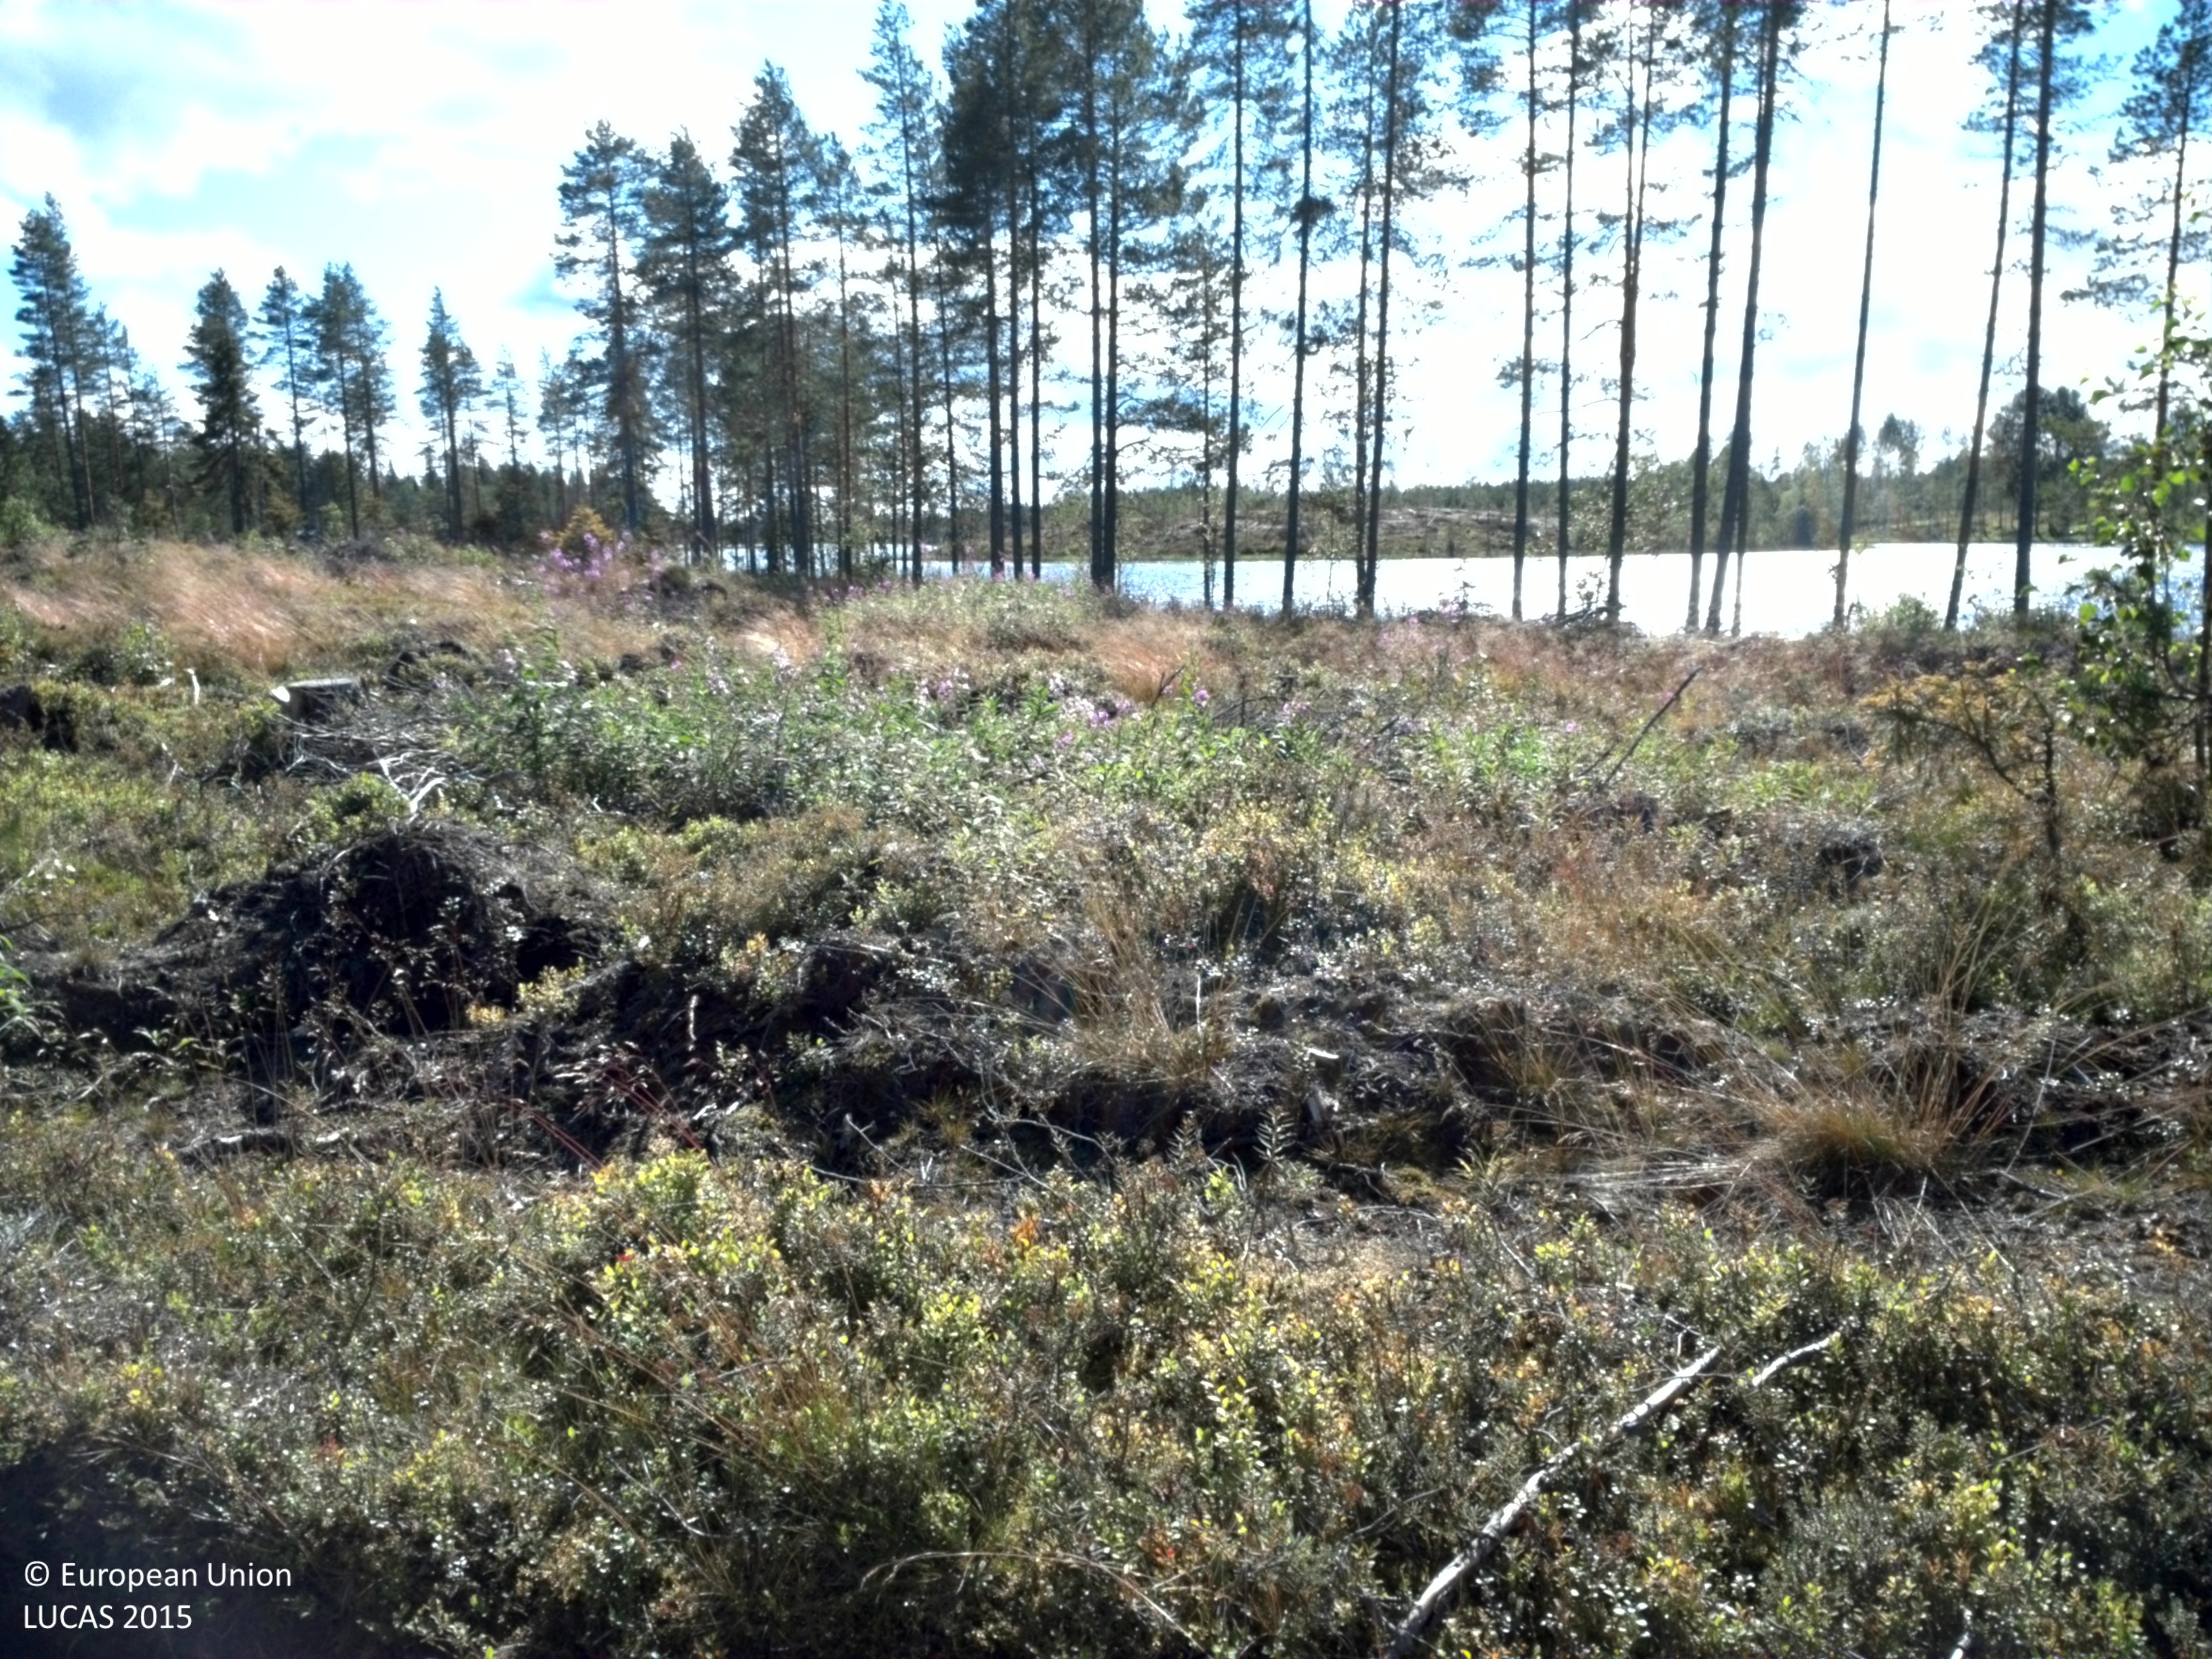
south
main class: Shrubland
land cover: Shrubland with sparse tree cover
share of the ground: > 75 %
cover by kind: shrubs 80 %, unconsolidated bare surface 15 %, coniferous forest trees 5 %
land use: Forestry
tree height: < 5 m
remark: Clear cut
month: August
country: SE
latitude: 66.0781
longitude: 22.5979
